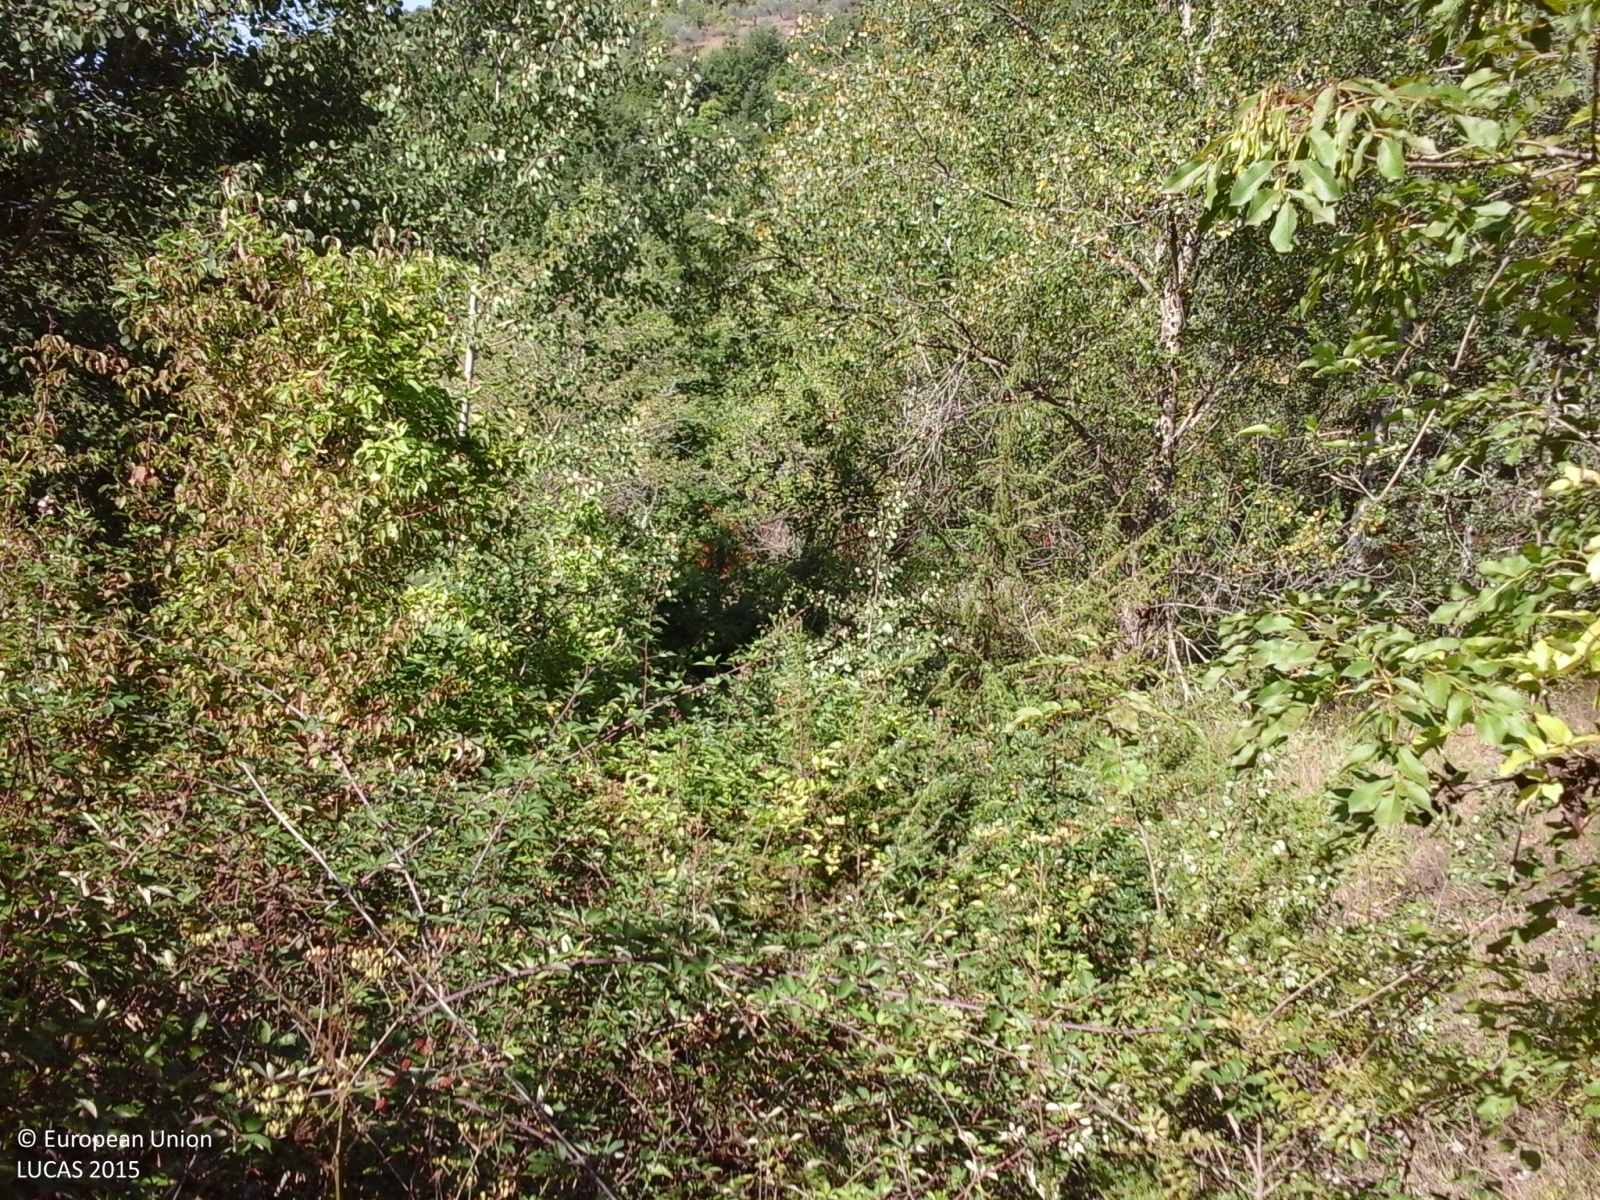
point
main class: Woodland
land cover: Broadleaved woodland
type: thermophilous deciduous forest
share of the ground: > 75 %
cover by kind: broadleaved forest trees 90 %, shrubs 5 %, herbaceous plants 5 %
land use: Semi-natural and natural areas not in use
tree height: > 5 m
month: September
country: IT
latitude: 41.6795
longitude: 14.2256
